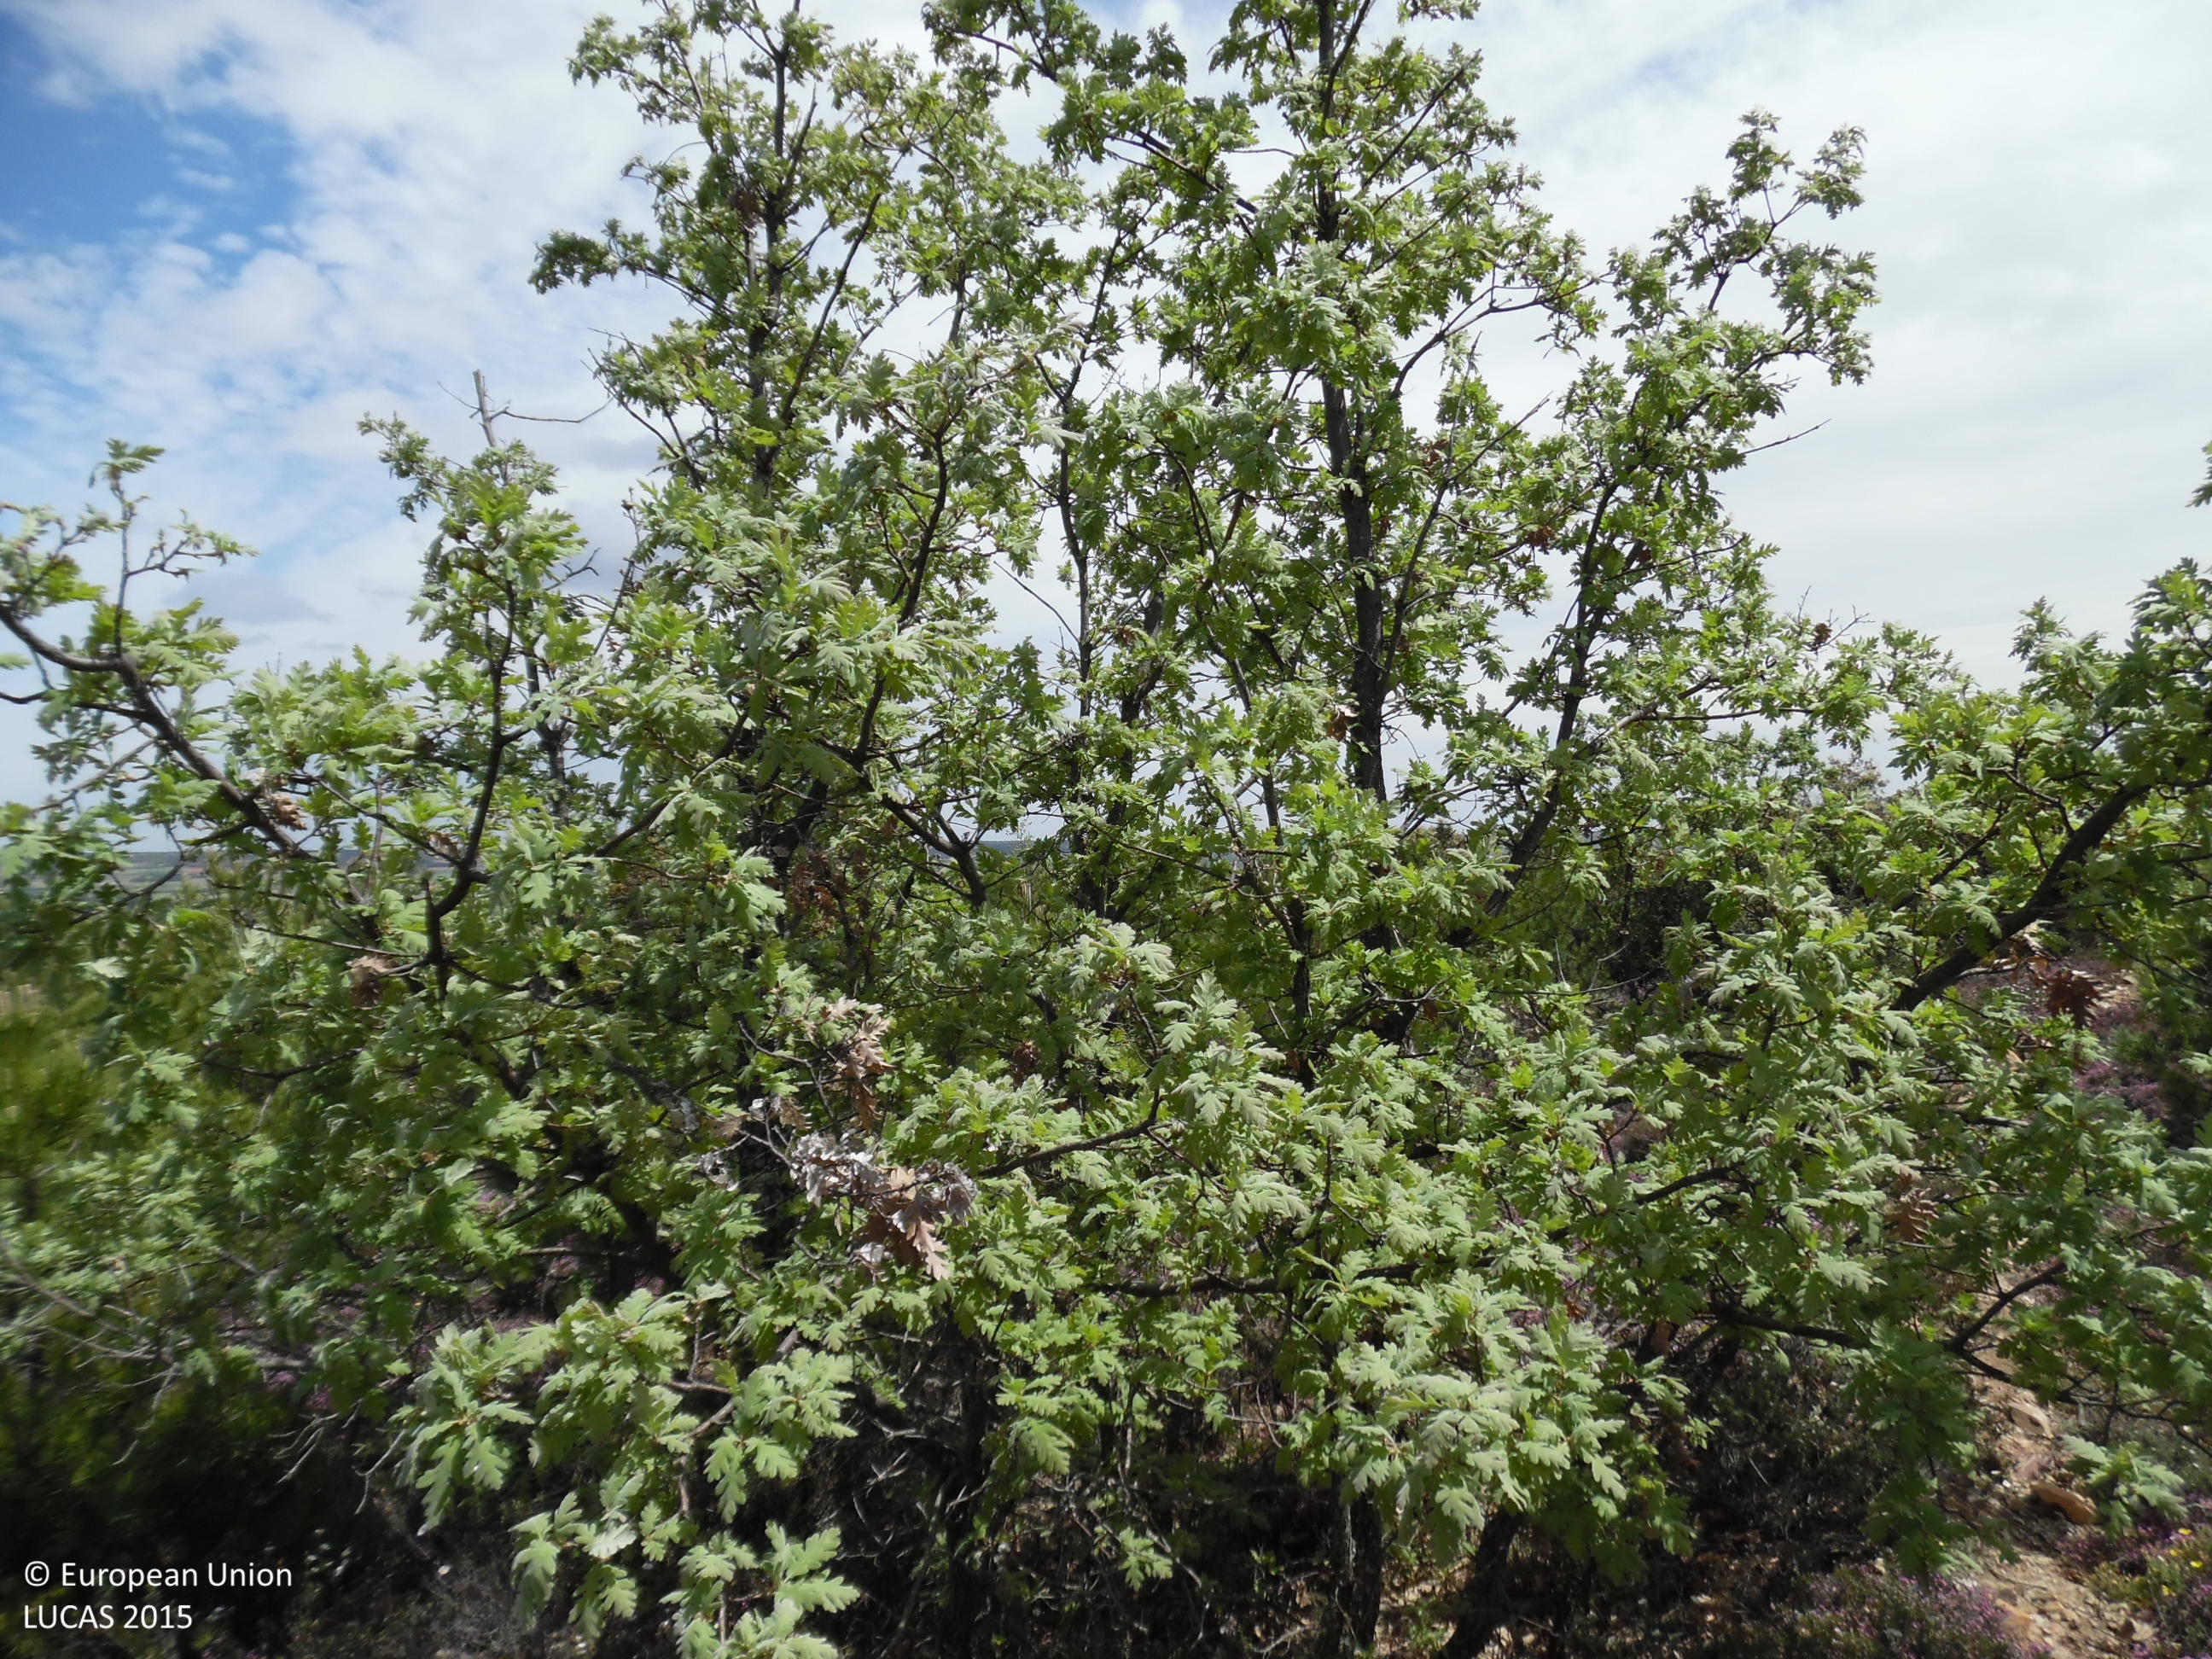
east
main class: Woodland
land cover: Pine dominated coniferous woodland
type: coniferous forest of the mediterranean region
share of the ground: > 75 %
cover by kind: coniferous forest trees 90 %, shrubs 10 %
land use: Forestry
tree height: > 5 m
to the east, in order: Pine dominated coniferous woodland
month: May
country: ES
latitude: 42.4982
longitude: -6.0838
